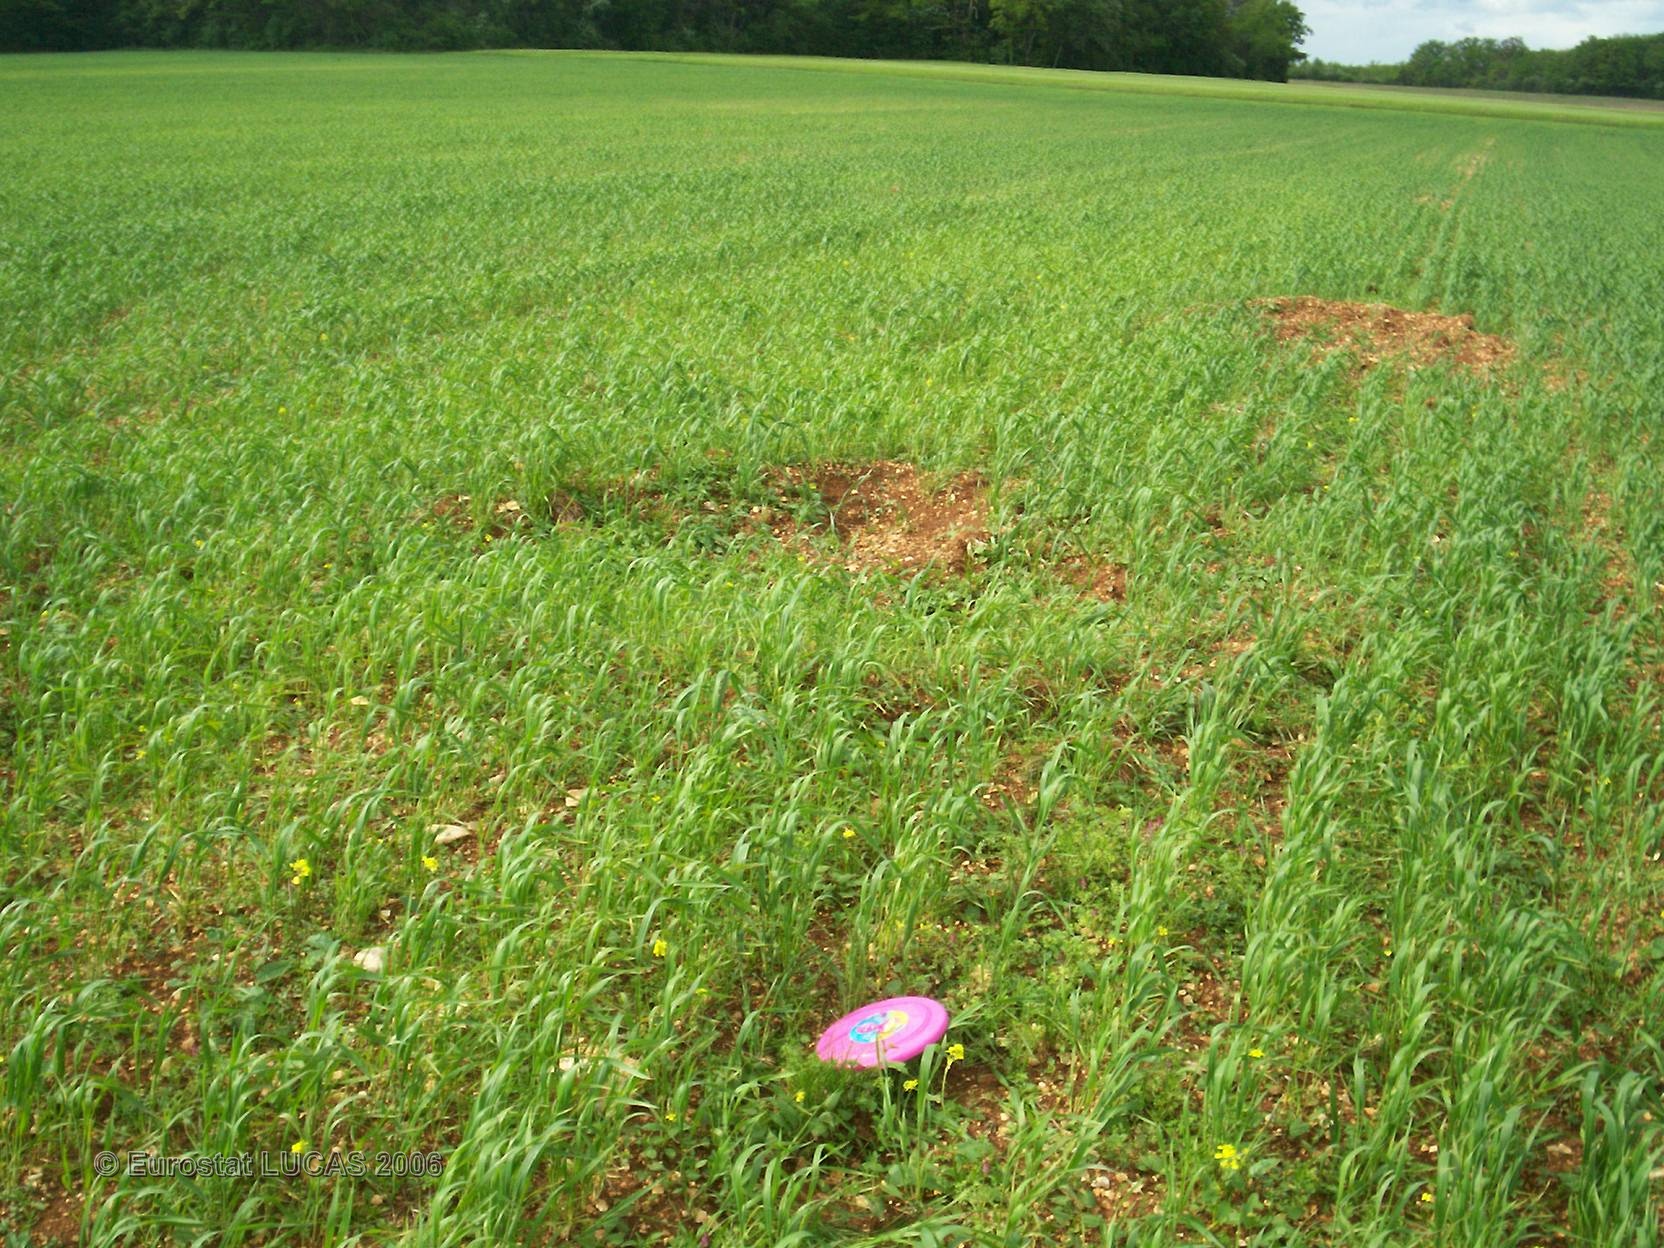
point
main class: Cropland
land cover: Barley
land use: Agriculture (excluding fallow land and kitchen gardens)
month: May
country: FR
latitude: 47.0125
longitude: 4.6730
